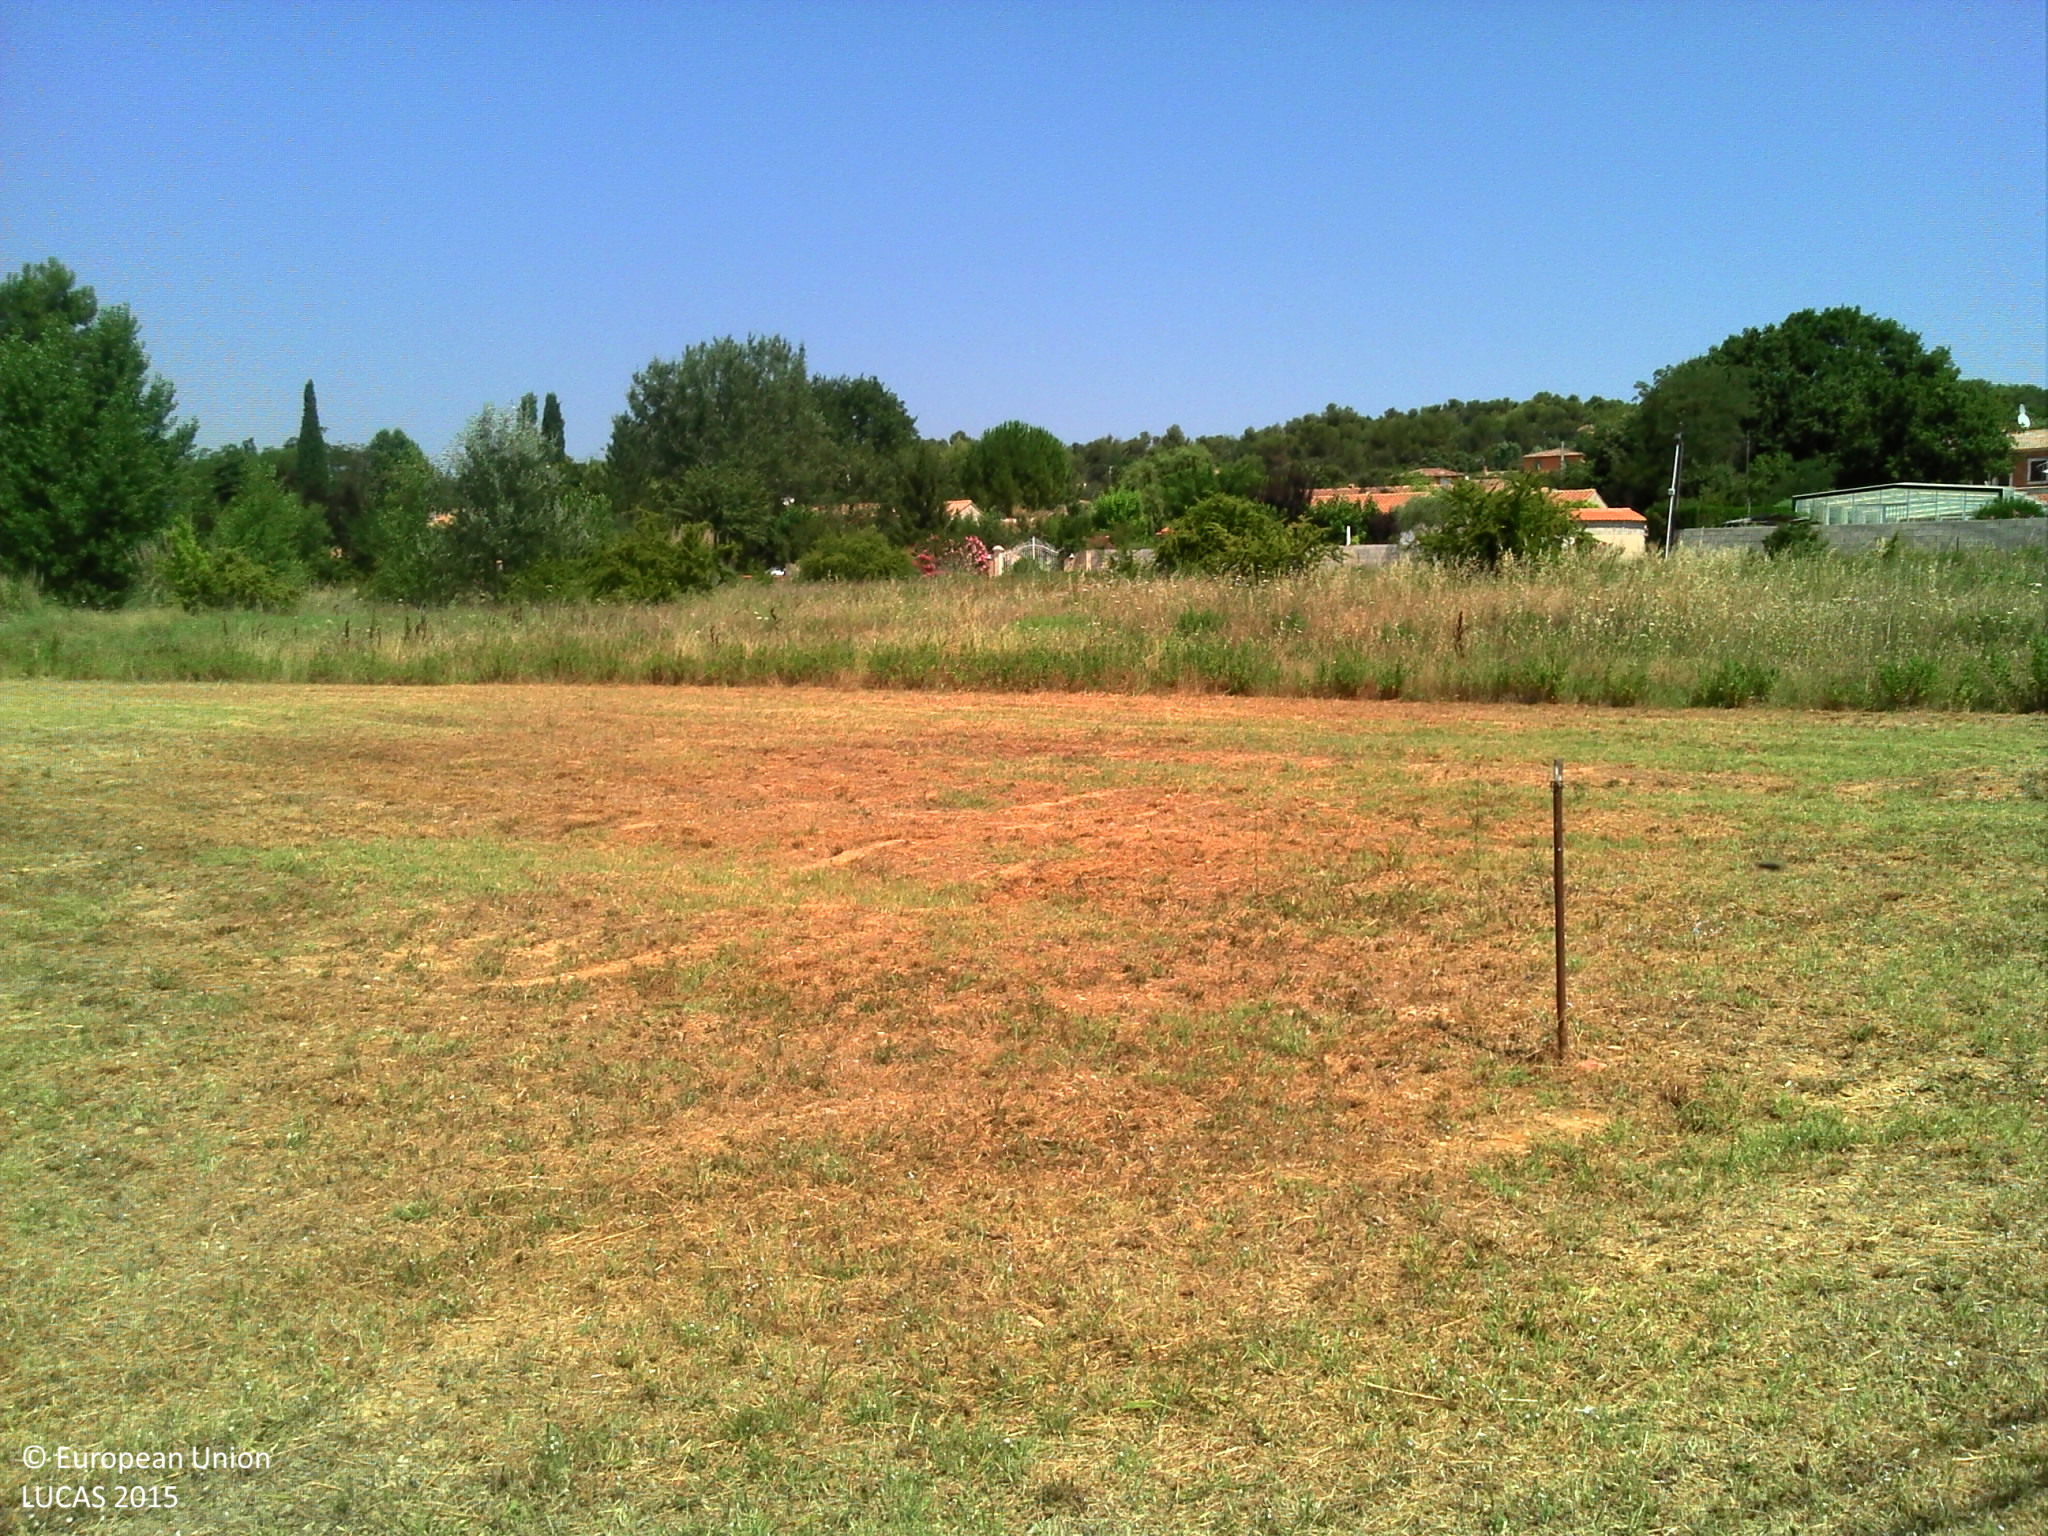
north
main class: Grassland
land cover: Grassland without tree/shrub cover
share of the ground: > 75 %
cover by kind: herbaceous plants 100 %
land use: Agriculture (excluding fallow land and kitchen gardens)
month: July
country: FR
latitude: 43.5045
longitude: 5.7424
